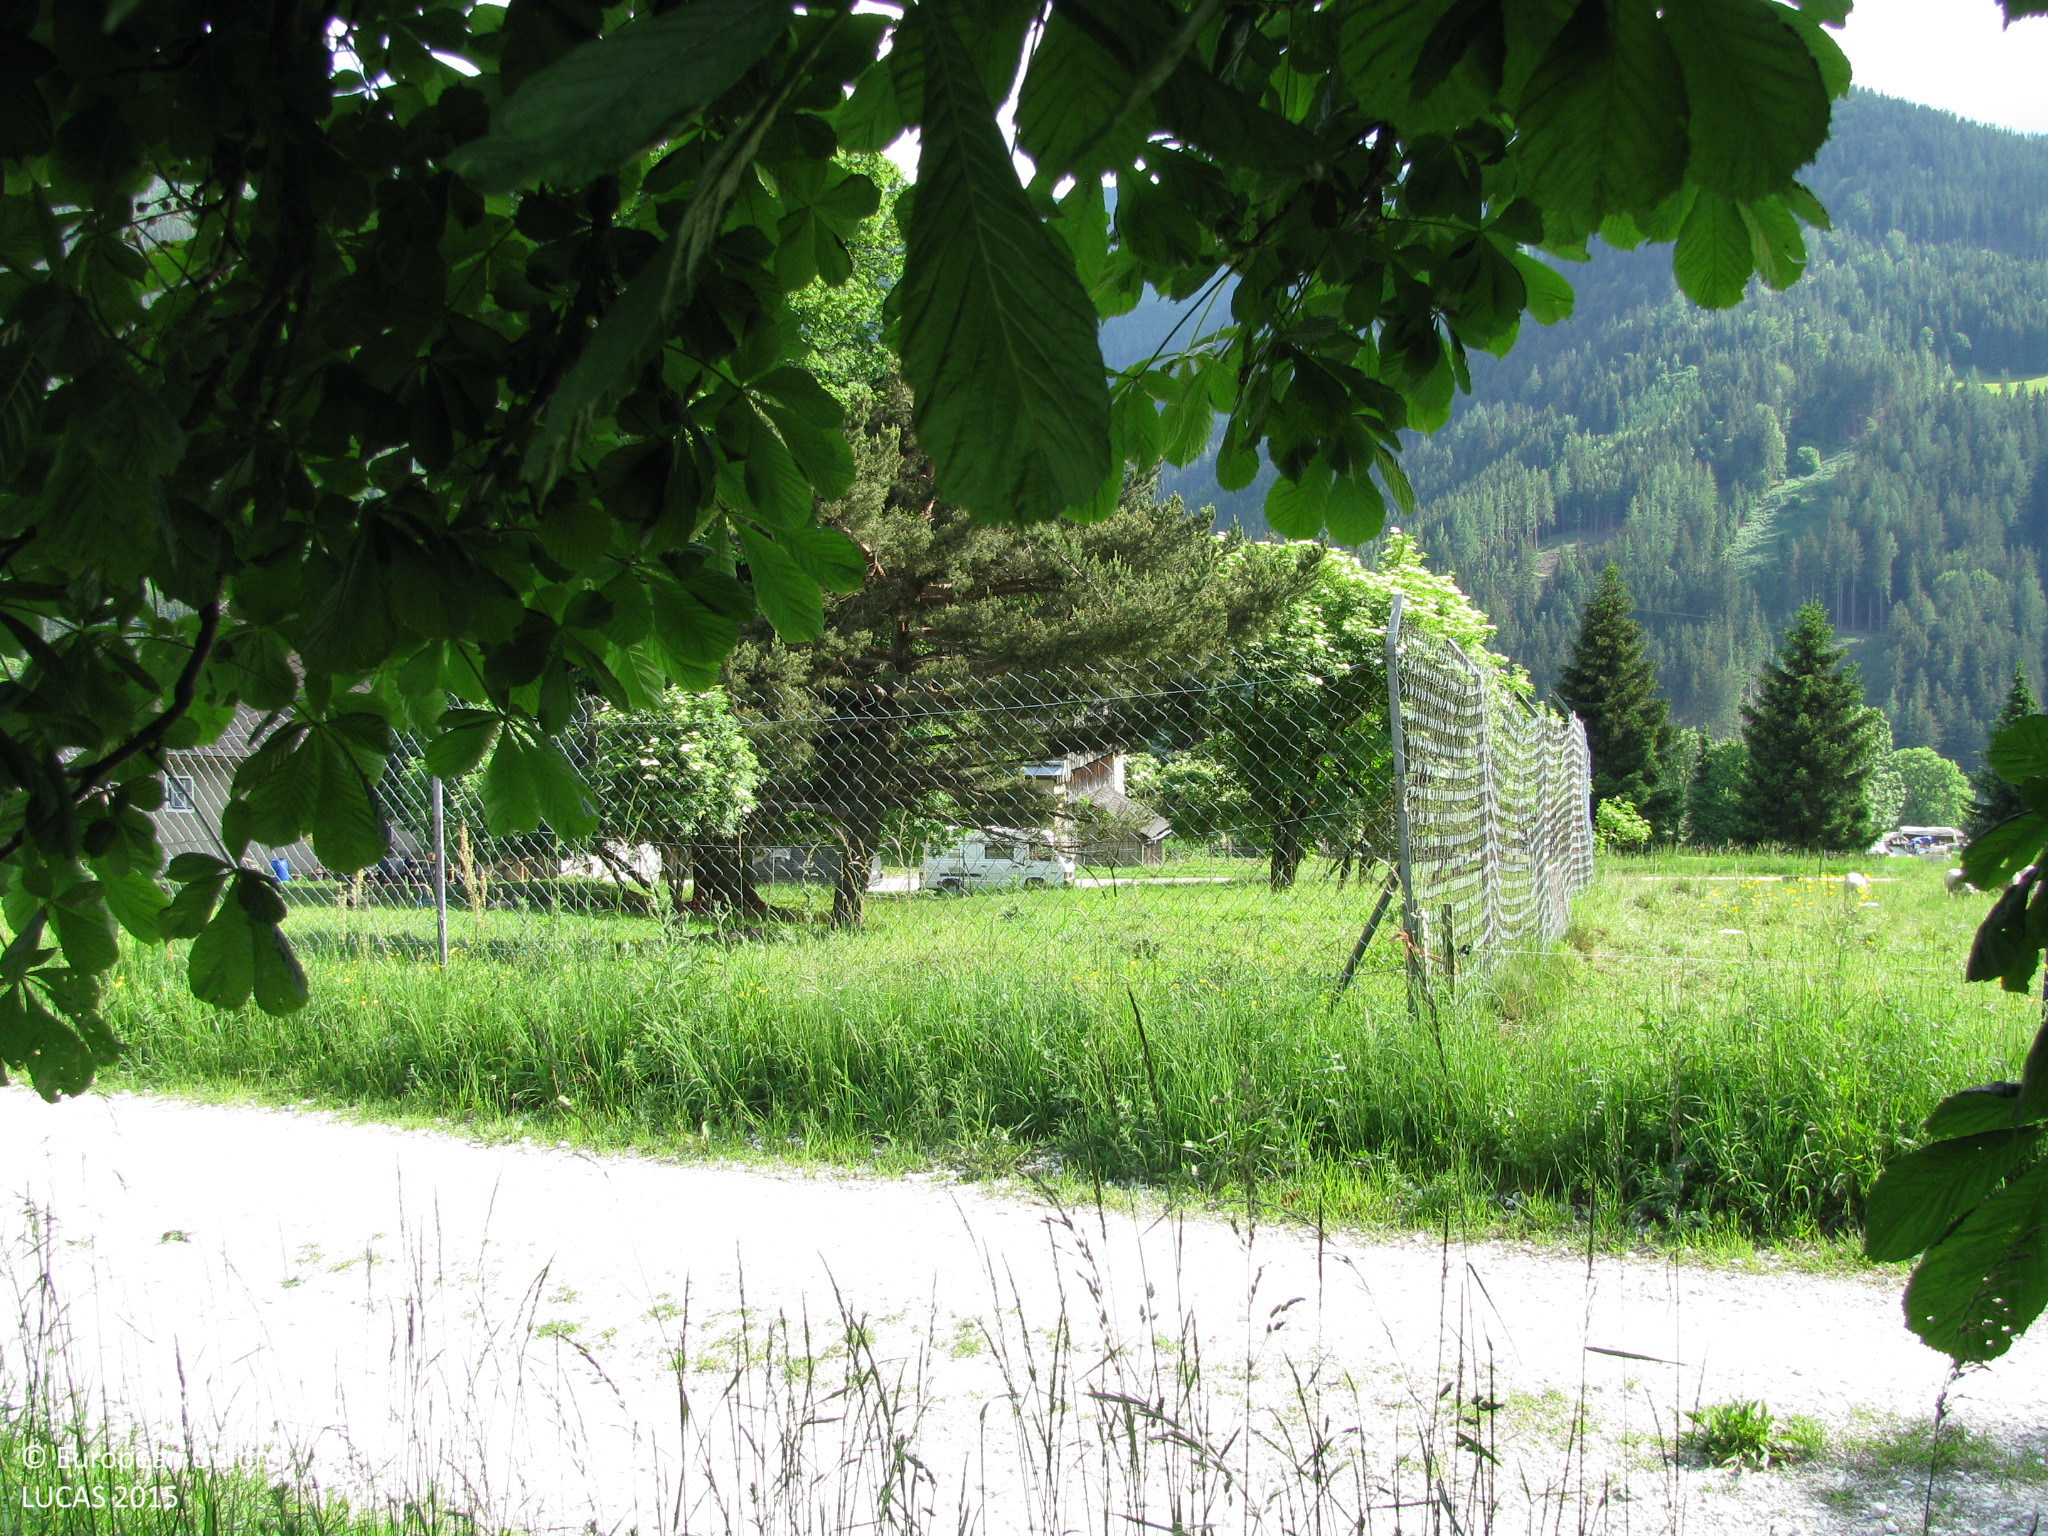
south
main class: Grassland
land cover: Grassland without tree/shrub cover
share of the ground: > 75 %
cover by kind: herbaceous plants 100 %
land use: Agriculture (excluding fallow land and kitchen gardens)
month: June
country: AT
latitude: 47.3939
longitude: 14.8883
